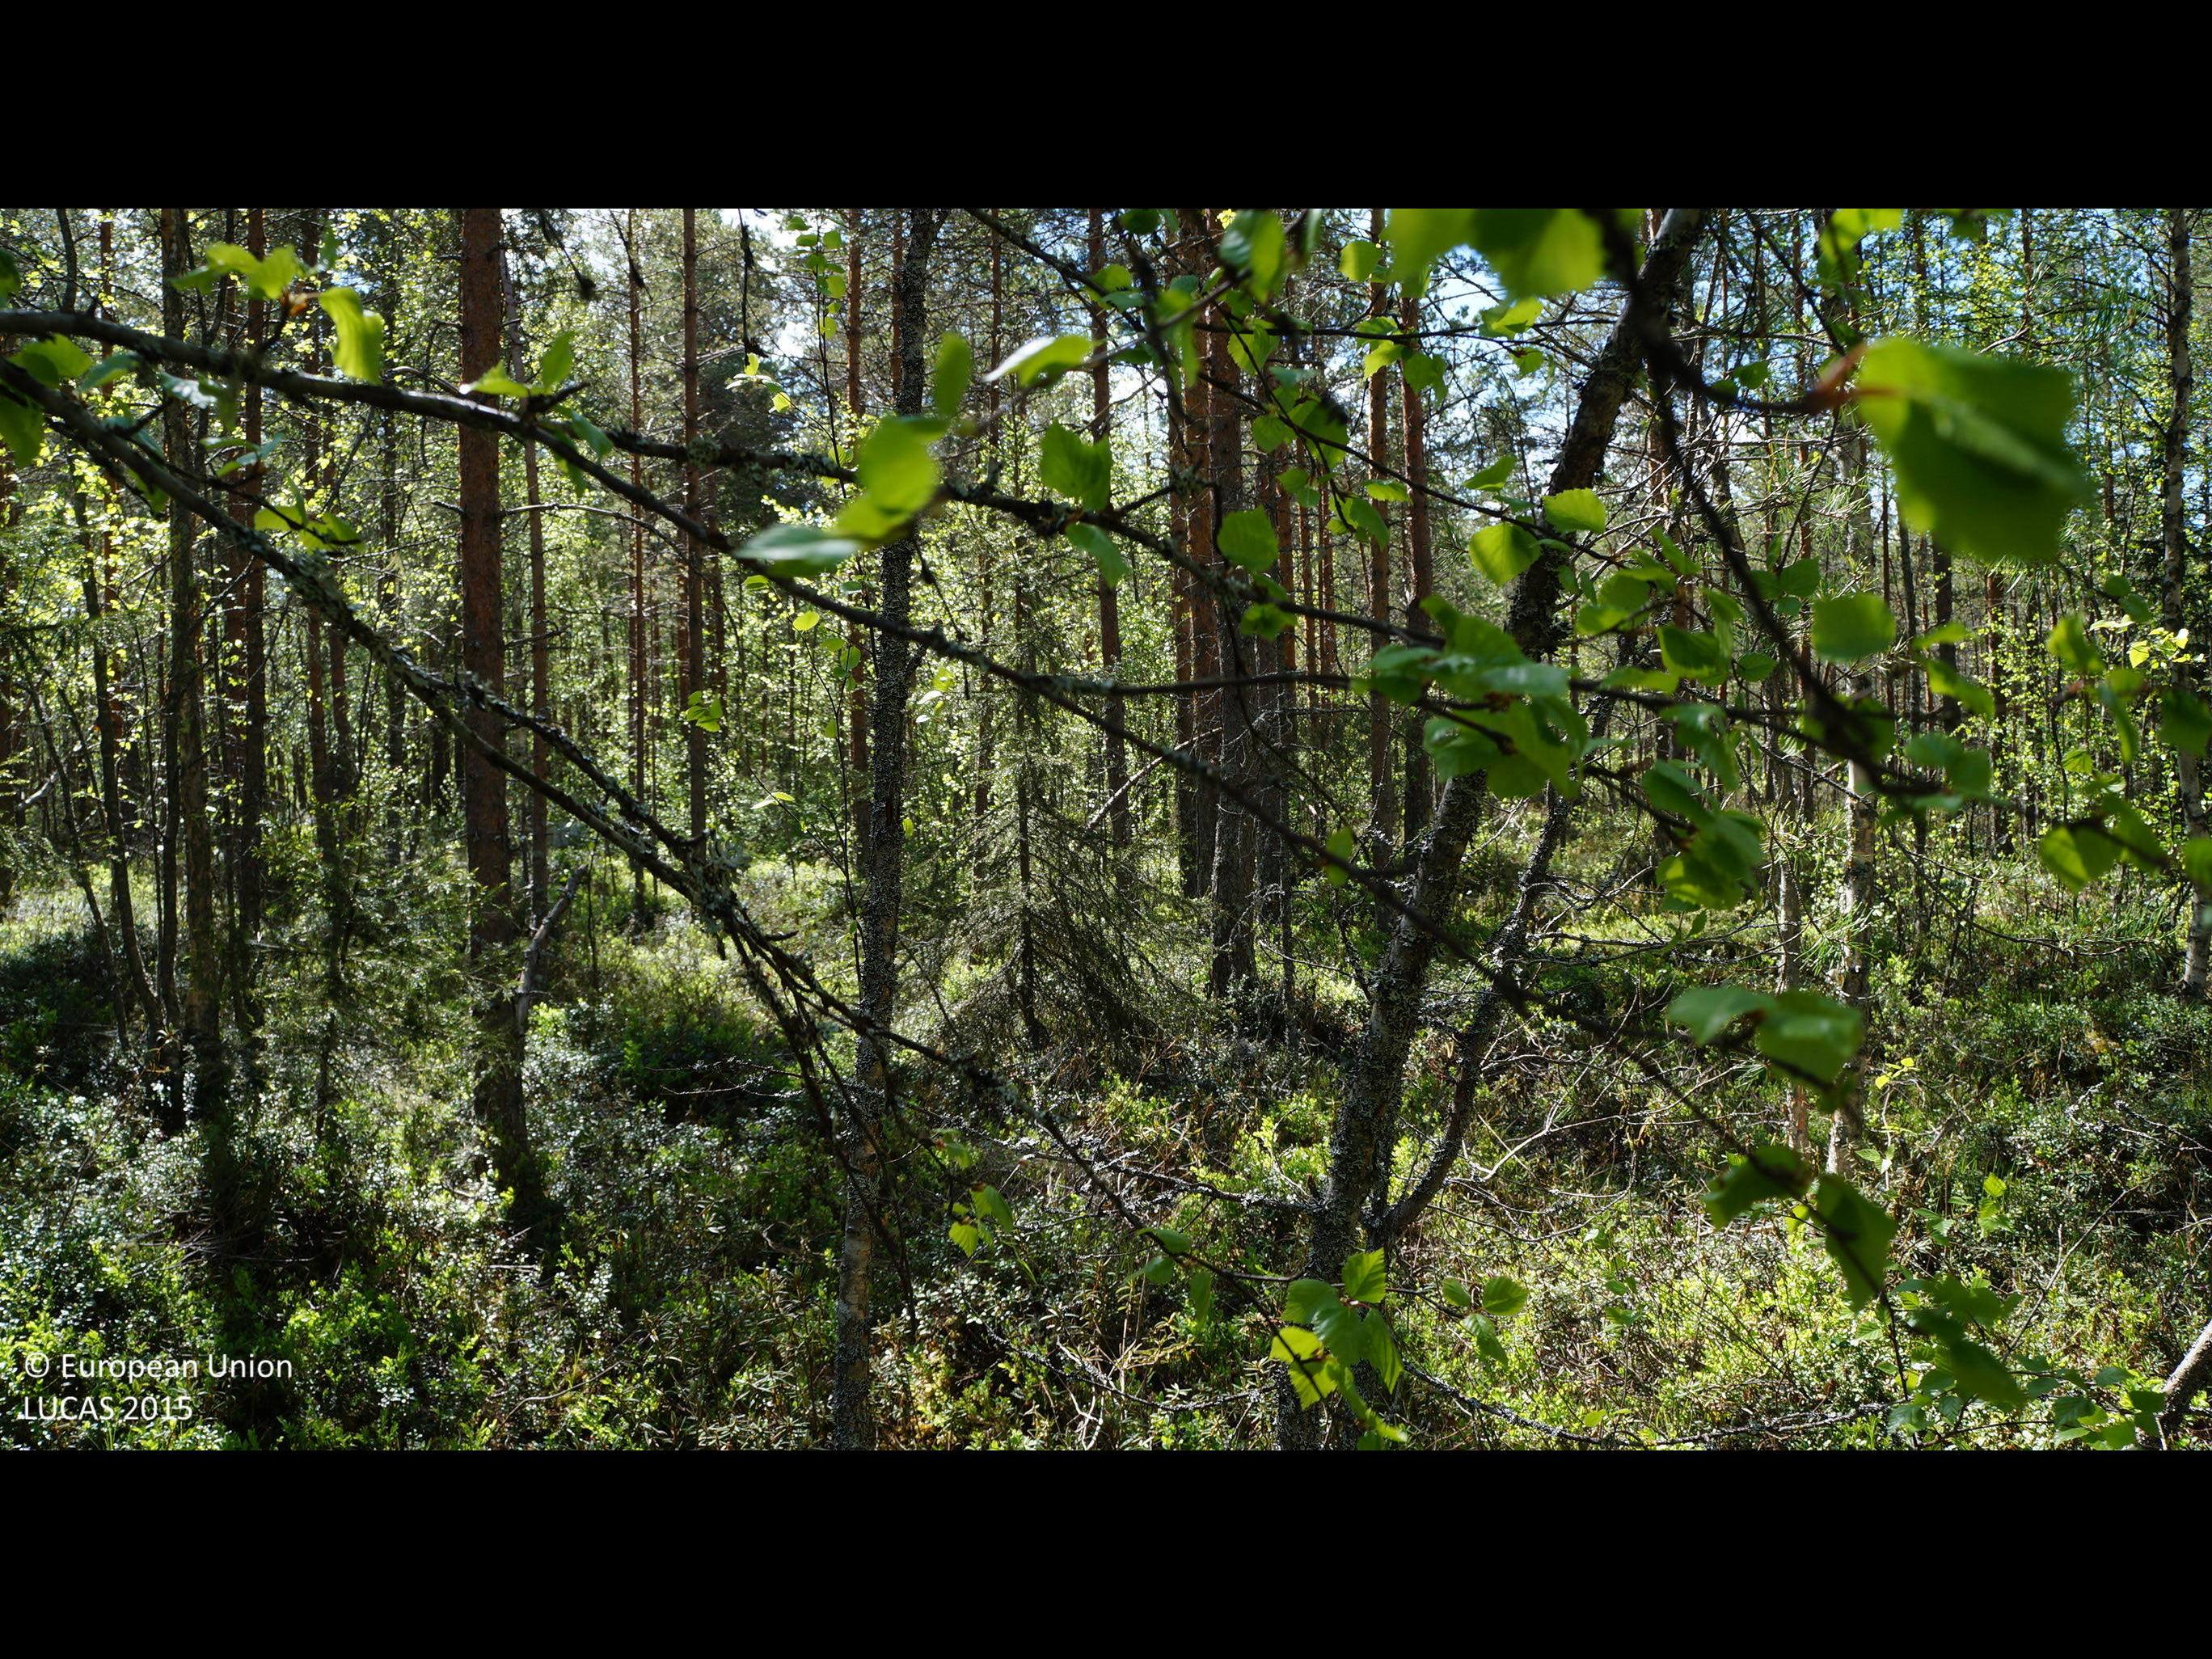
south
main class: Woodland
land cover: Pine dominated mixed woodland
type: boreal forest
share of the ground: > 75 %
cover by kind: coniferous forest trees 65 %, broadleaved forest trees 25 %, shrubs 10 %
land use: Forestry
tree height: > 5 m
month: June
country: FI
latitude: 63.7800
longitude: 23.3032
